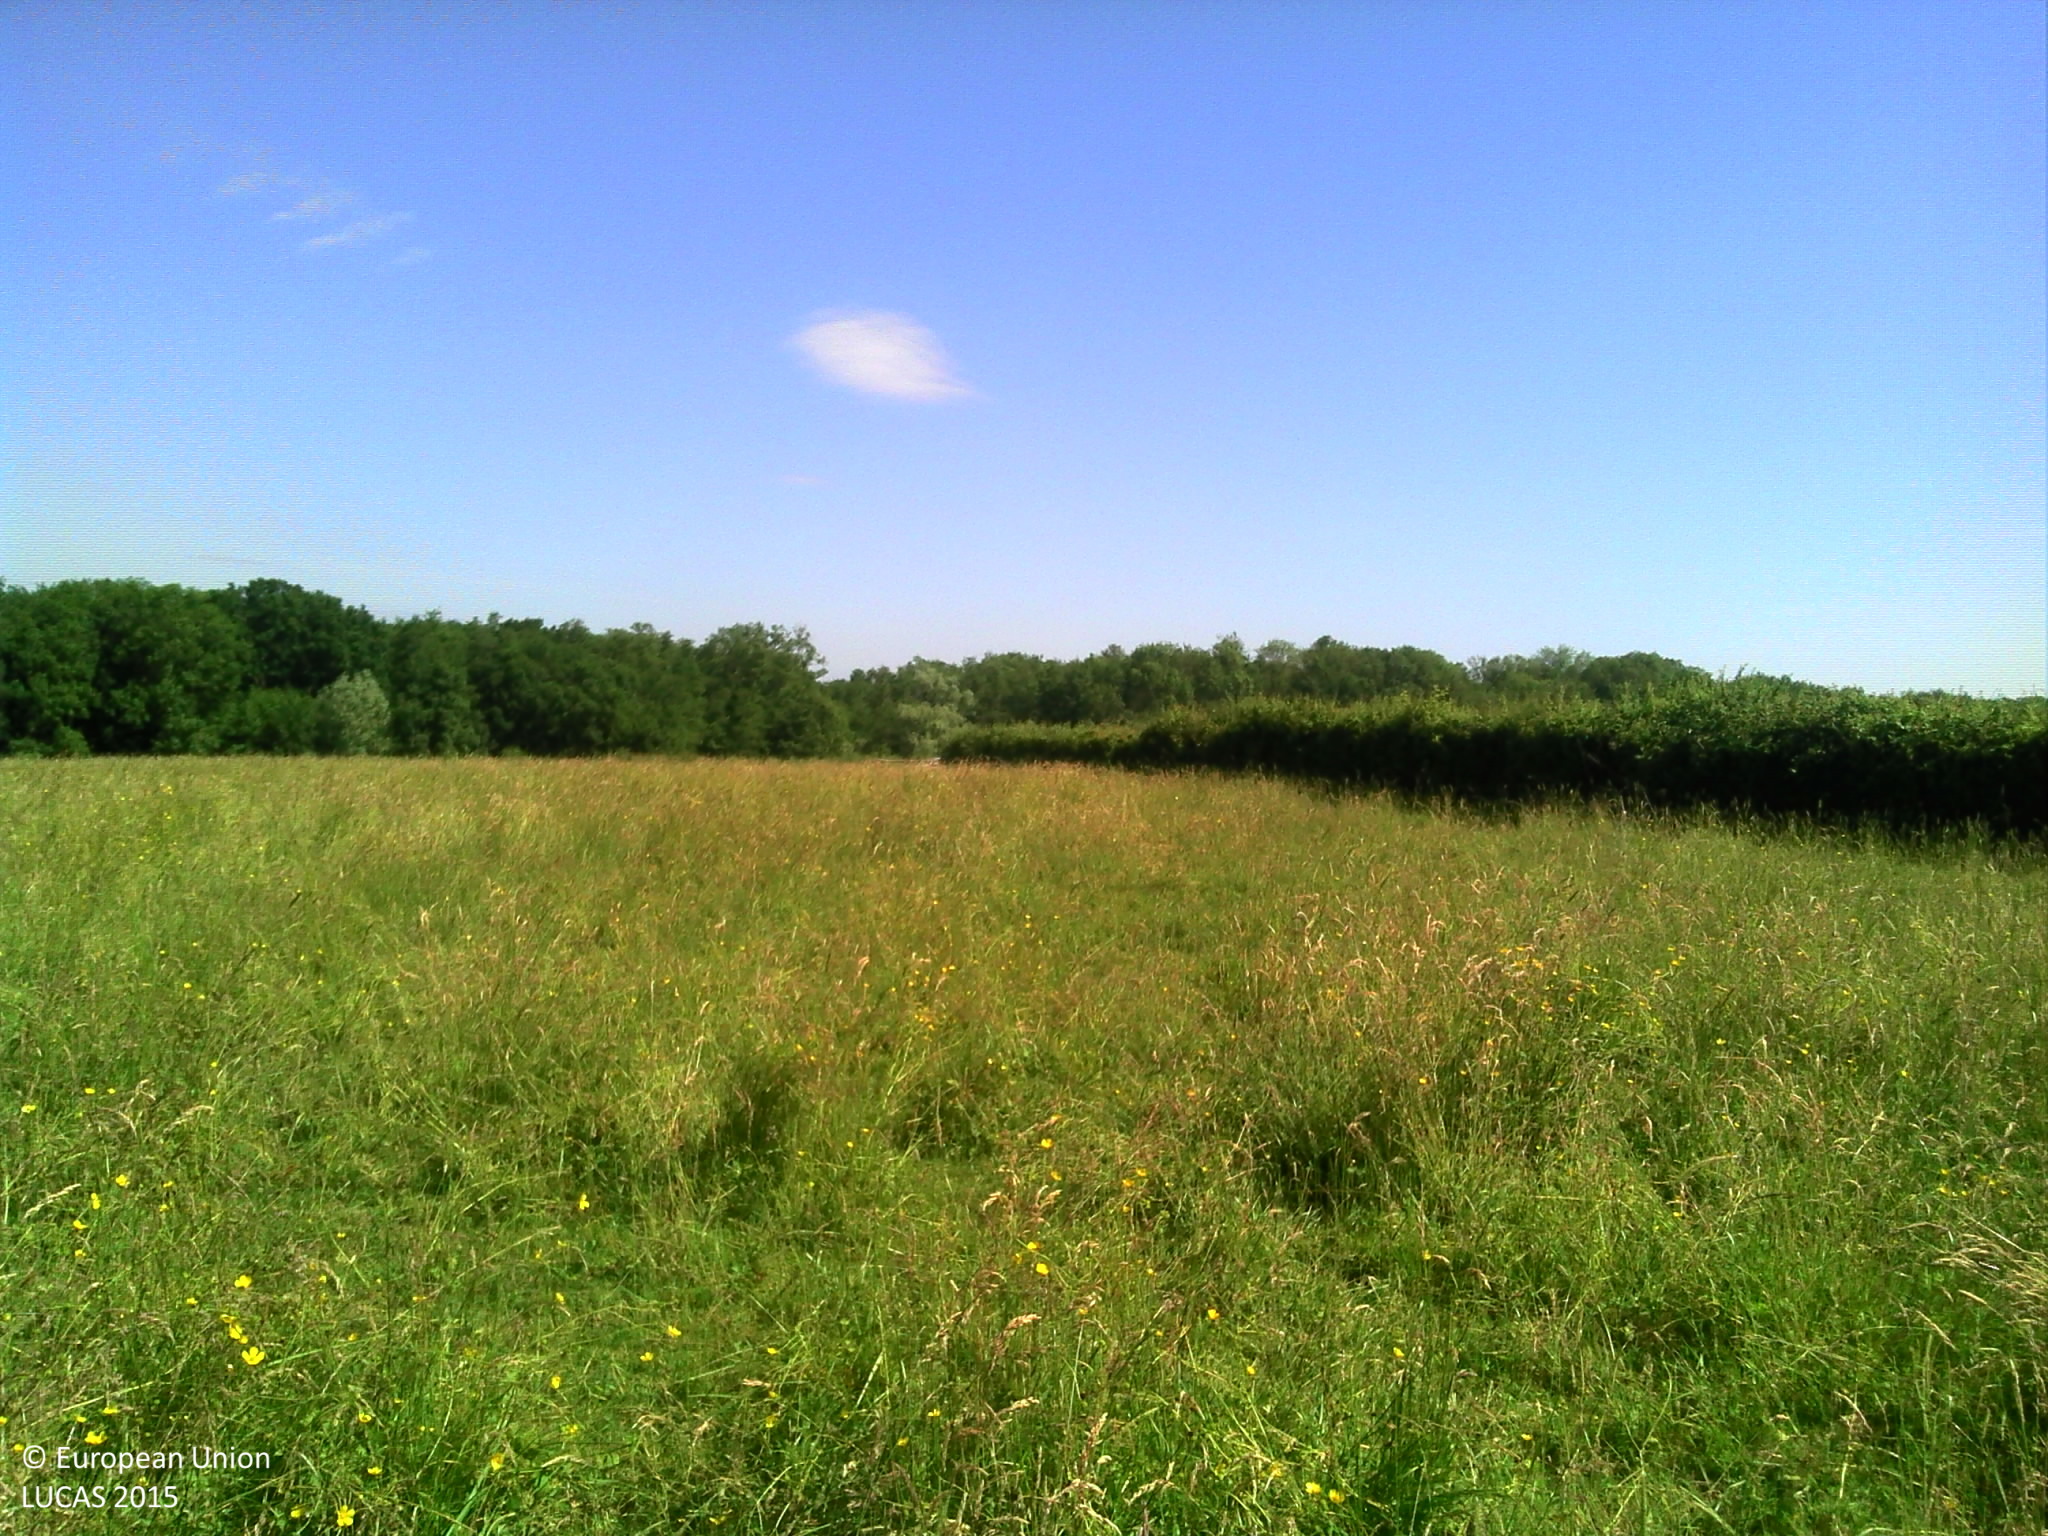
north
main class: Grassland
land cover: Grassland without tree/shrub cover
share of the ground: > 75 %
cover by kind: herbaceous plants 100 %
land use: Agriculture (excluding fallow land and kitchen gardens)
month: June
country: FR
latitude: 46.6393
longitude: 4.7891
